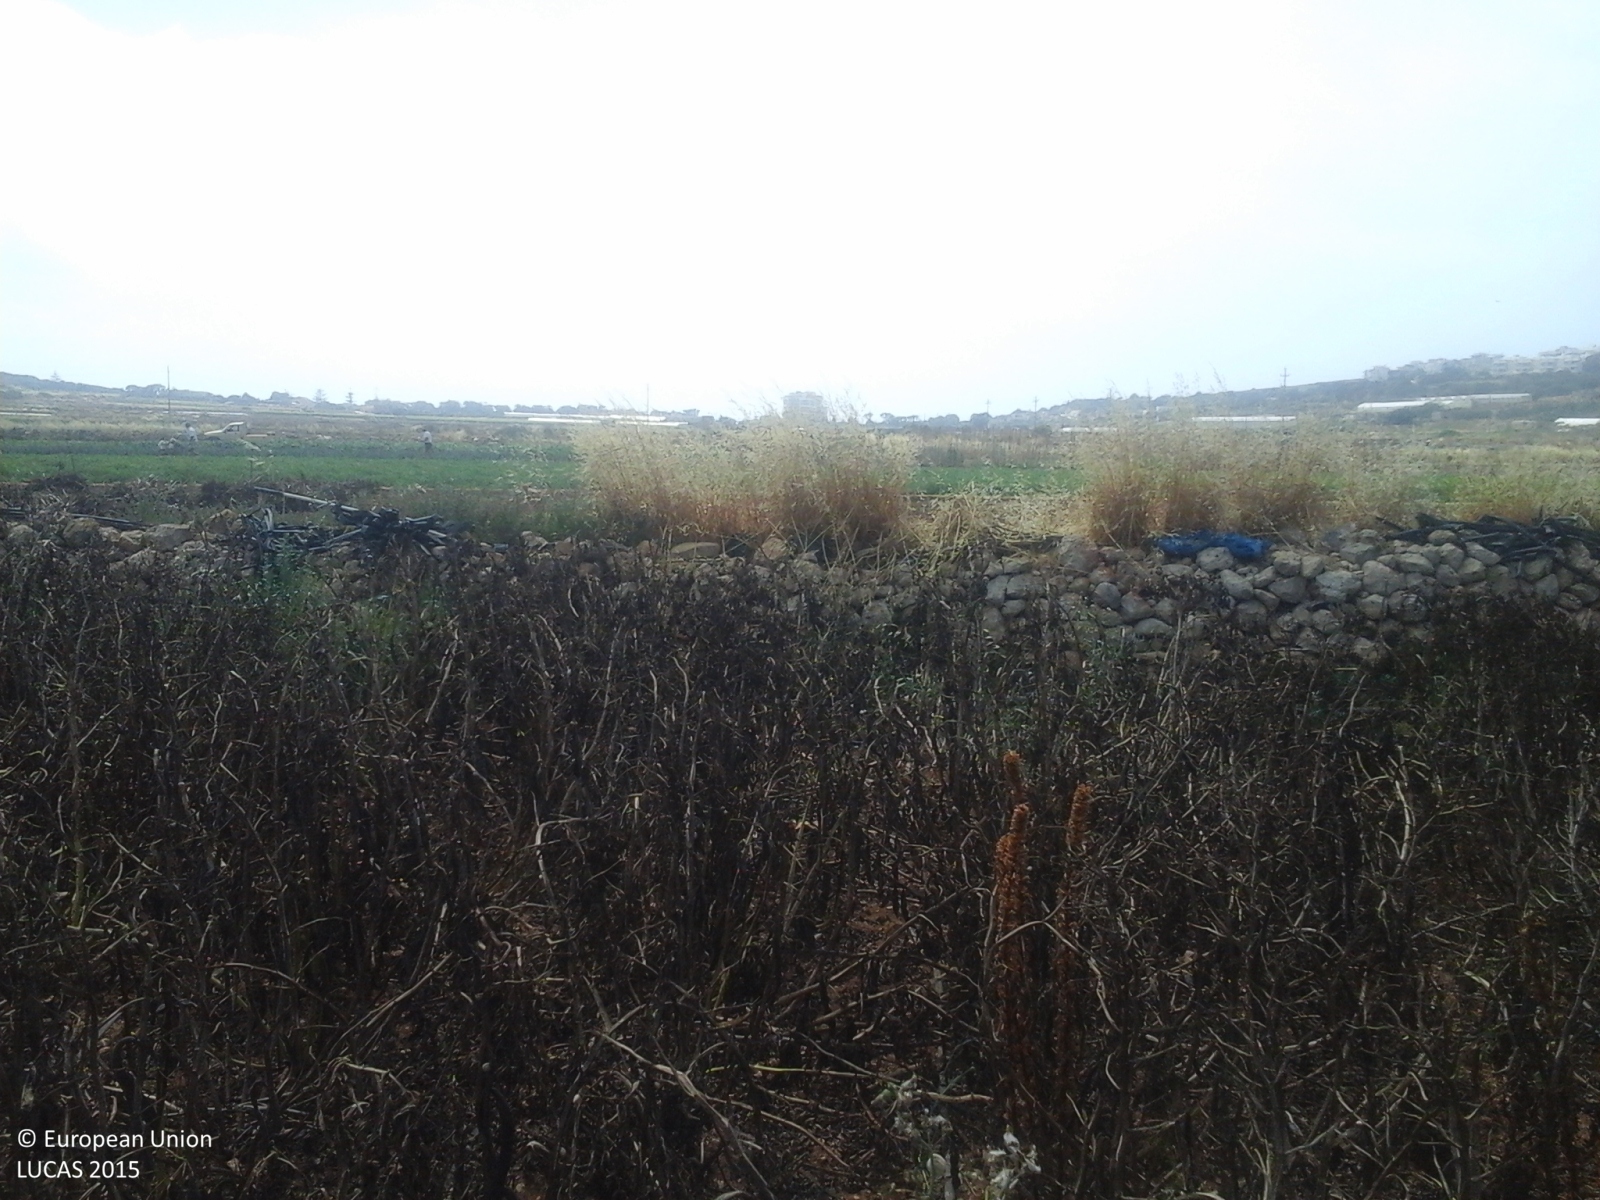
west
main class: Cropland
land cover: Dry pulses
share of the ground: > 75 %
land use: Agriculture (excluding fallow land and kitchen gardens)
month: May
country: MT
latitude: 35.9371
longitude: 14.3604
